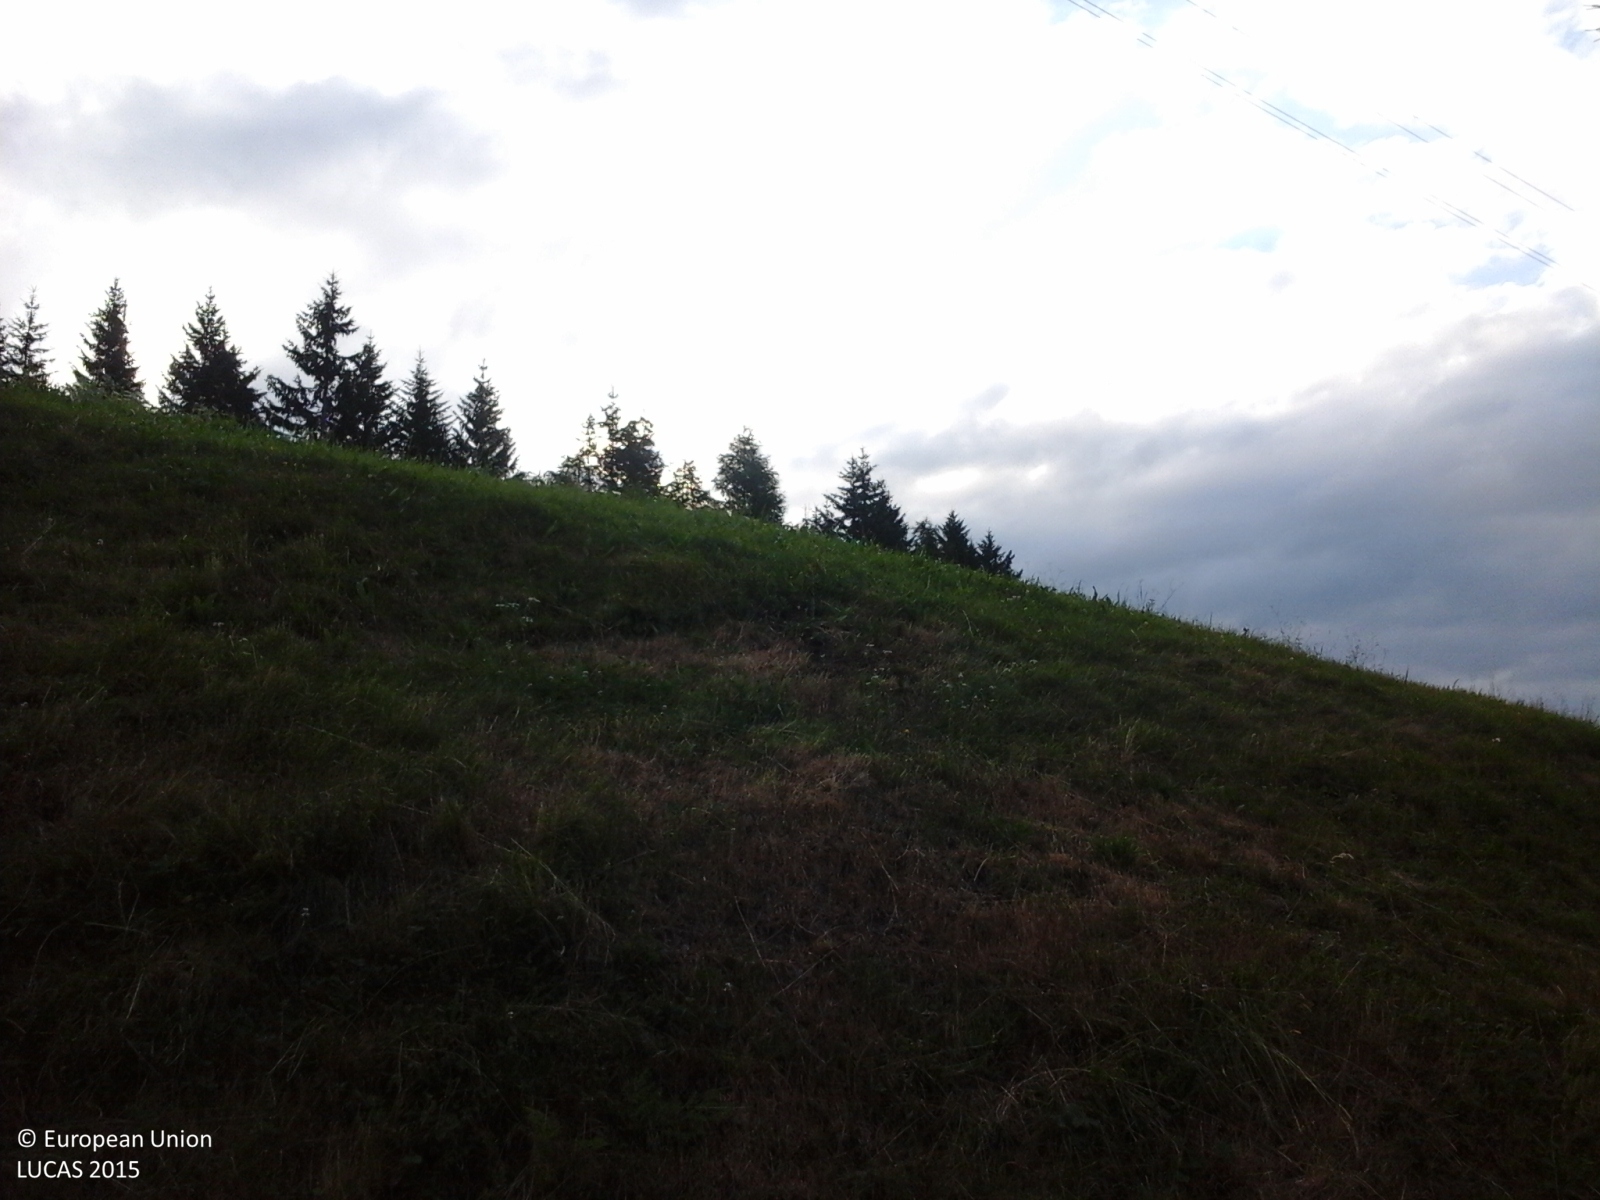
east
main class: Grassland
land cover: Grassland without tree/shrub cover
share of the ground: > 75 %
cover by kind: herbaceous plants 100 %
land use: Agriculture (excluding fallow land and kitchen gardens)
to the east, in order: Grassland without tree/shrub cover; Fences; Grassland without tree/shrub cover; Fences; Grassland without tree/shrub cover; Artificial constructions; Grassland without tree/shrub cover; Tracks; Grassland without tree/shrub cover; Tracks; Grassland without tree/shrub cover
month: July
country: IT
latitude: 46.7690
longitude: 11.7659
